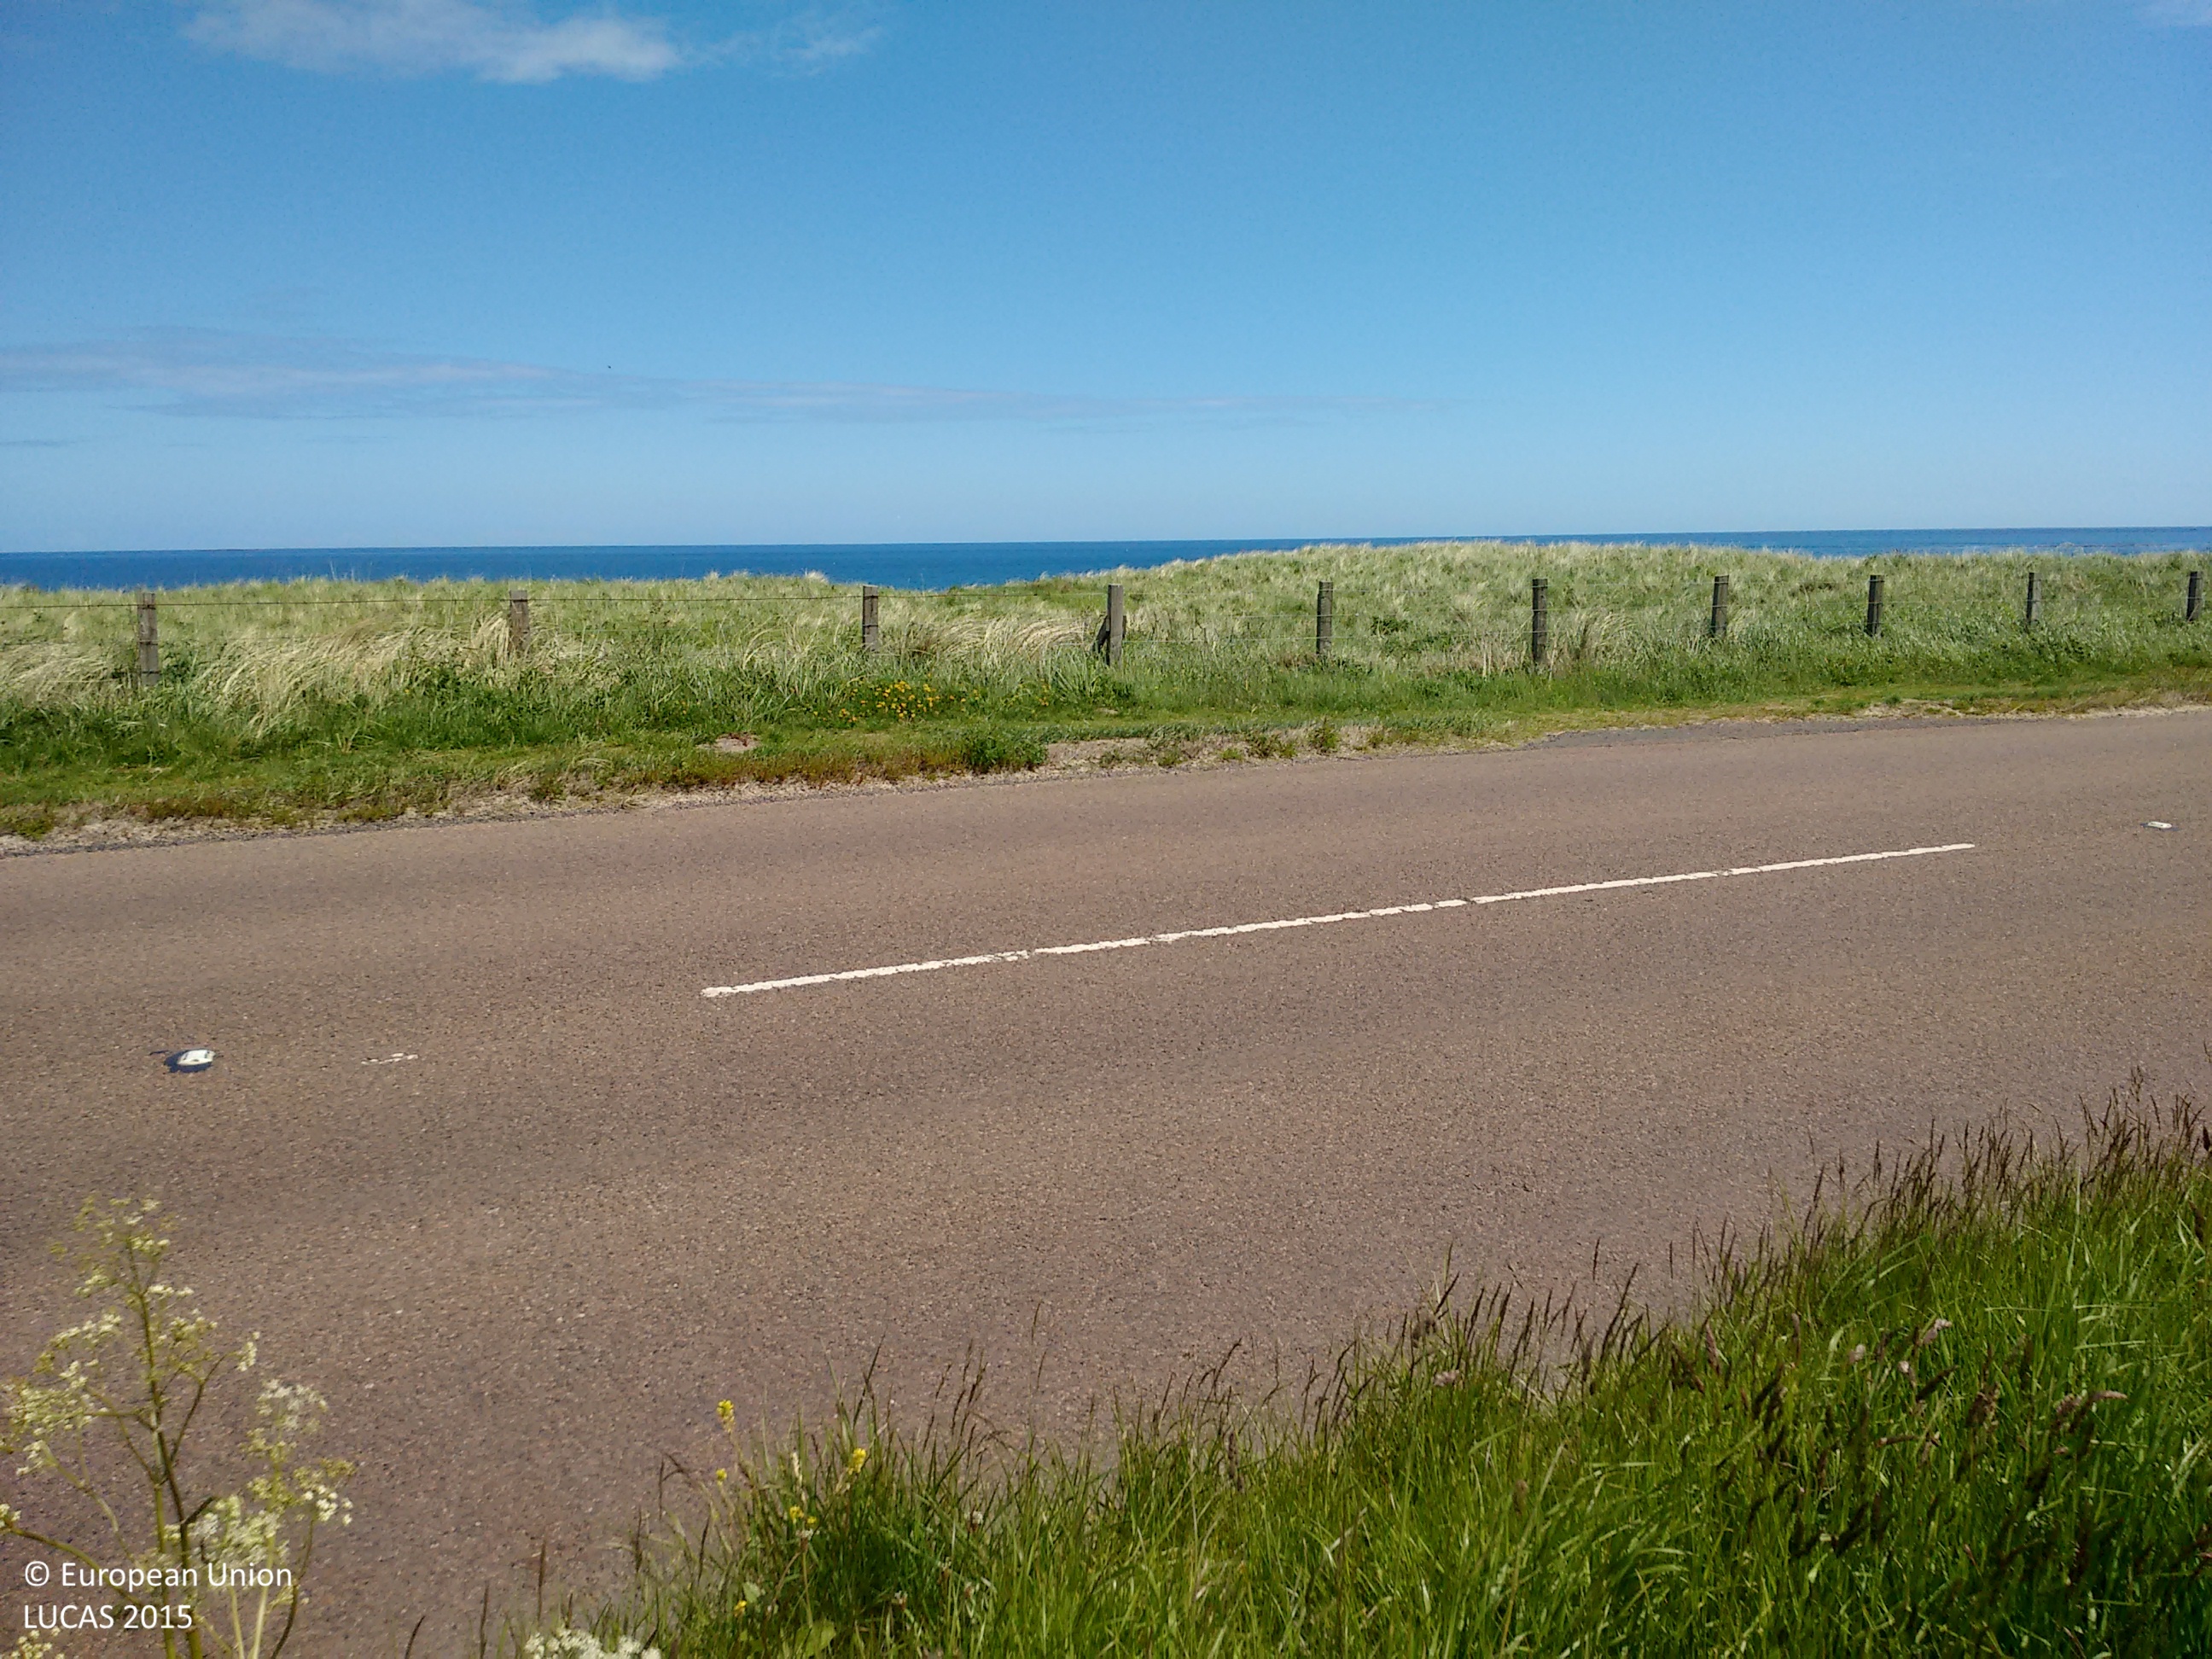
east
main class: Grassland
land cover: Grassland without tree/shrub cover
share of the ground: > 75 %
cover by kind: herbaceous plants 100 %
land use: Road transport
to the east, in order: Grassland without tree/shrub cover; Paved roads, cycling and walking lanes; Grassland without tree/shrub cover; Fences; Grassland without tree/shrub cover; Rock outcrops; Sand; Intertidal flats
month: June
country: GB
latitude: 55.5976
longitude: -1.6808
